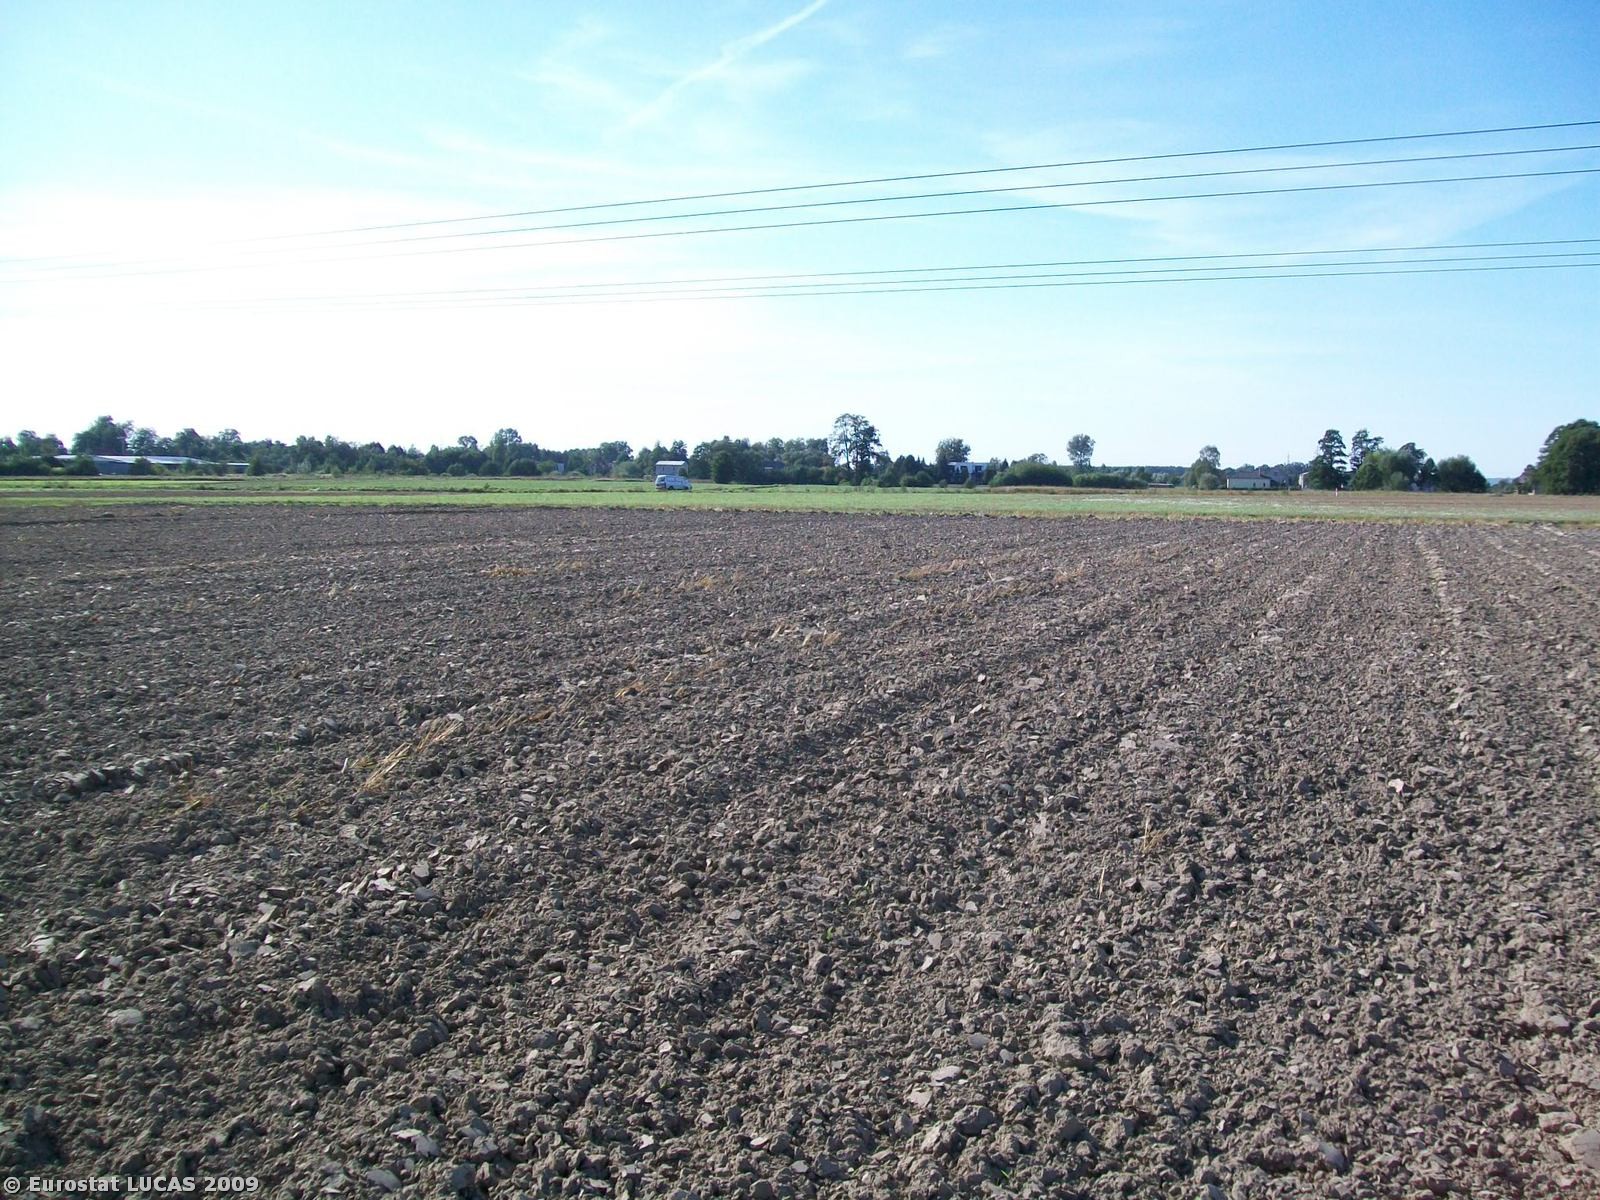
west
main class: Cropland
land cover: Oats
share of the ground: < 10 %
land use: Agriculture (excluding fallow land and kitchen gardens)
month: September
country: PL
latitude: 51.2959
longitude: 17.9752
